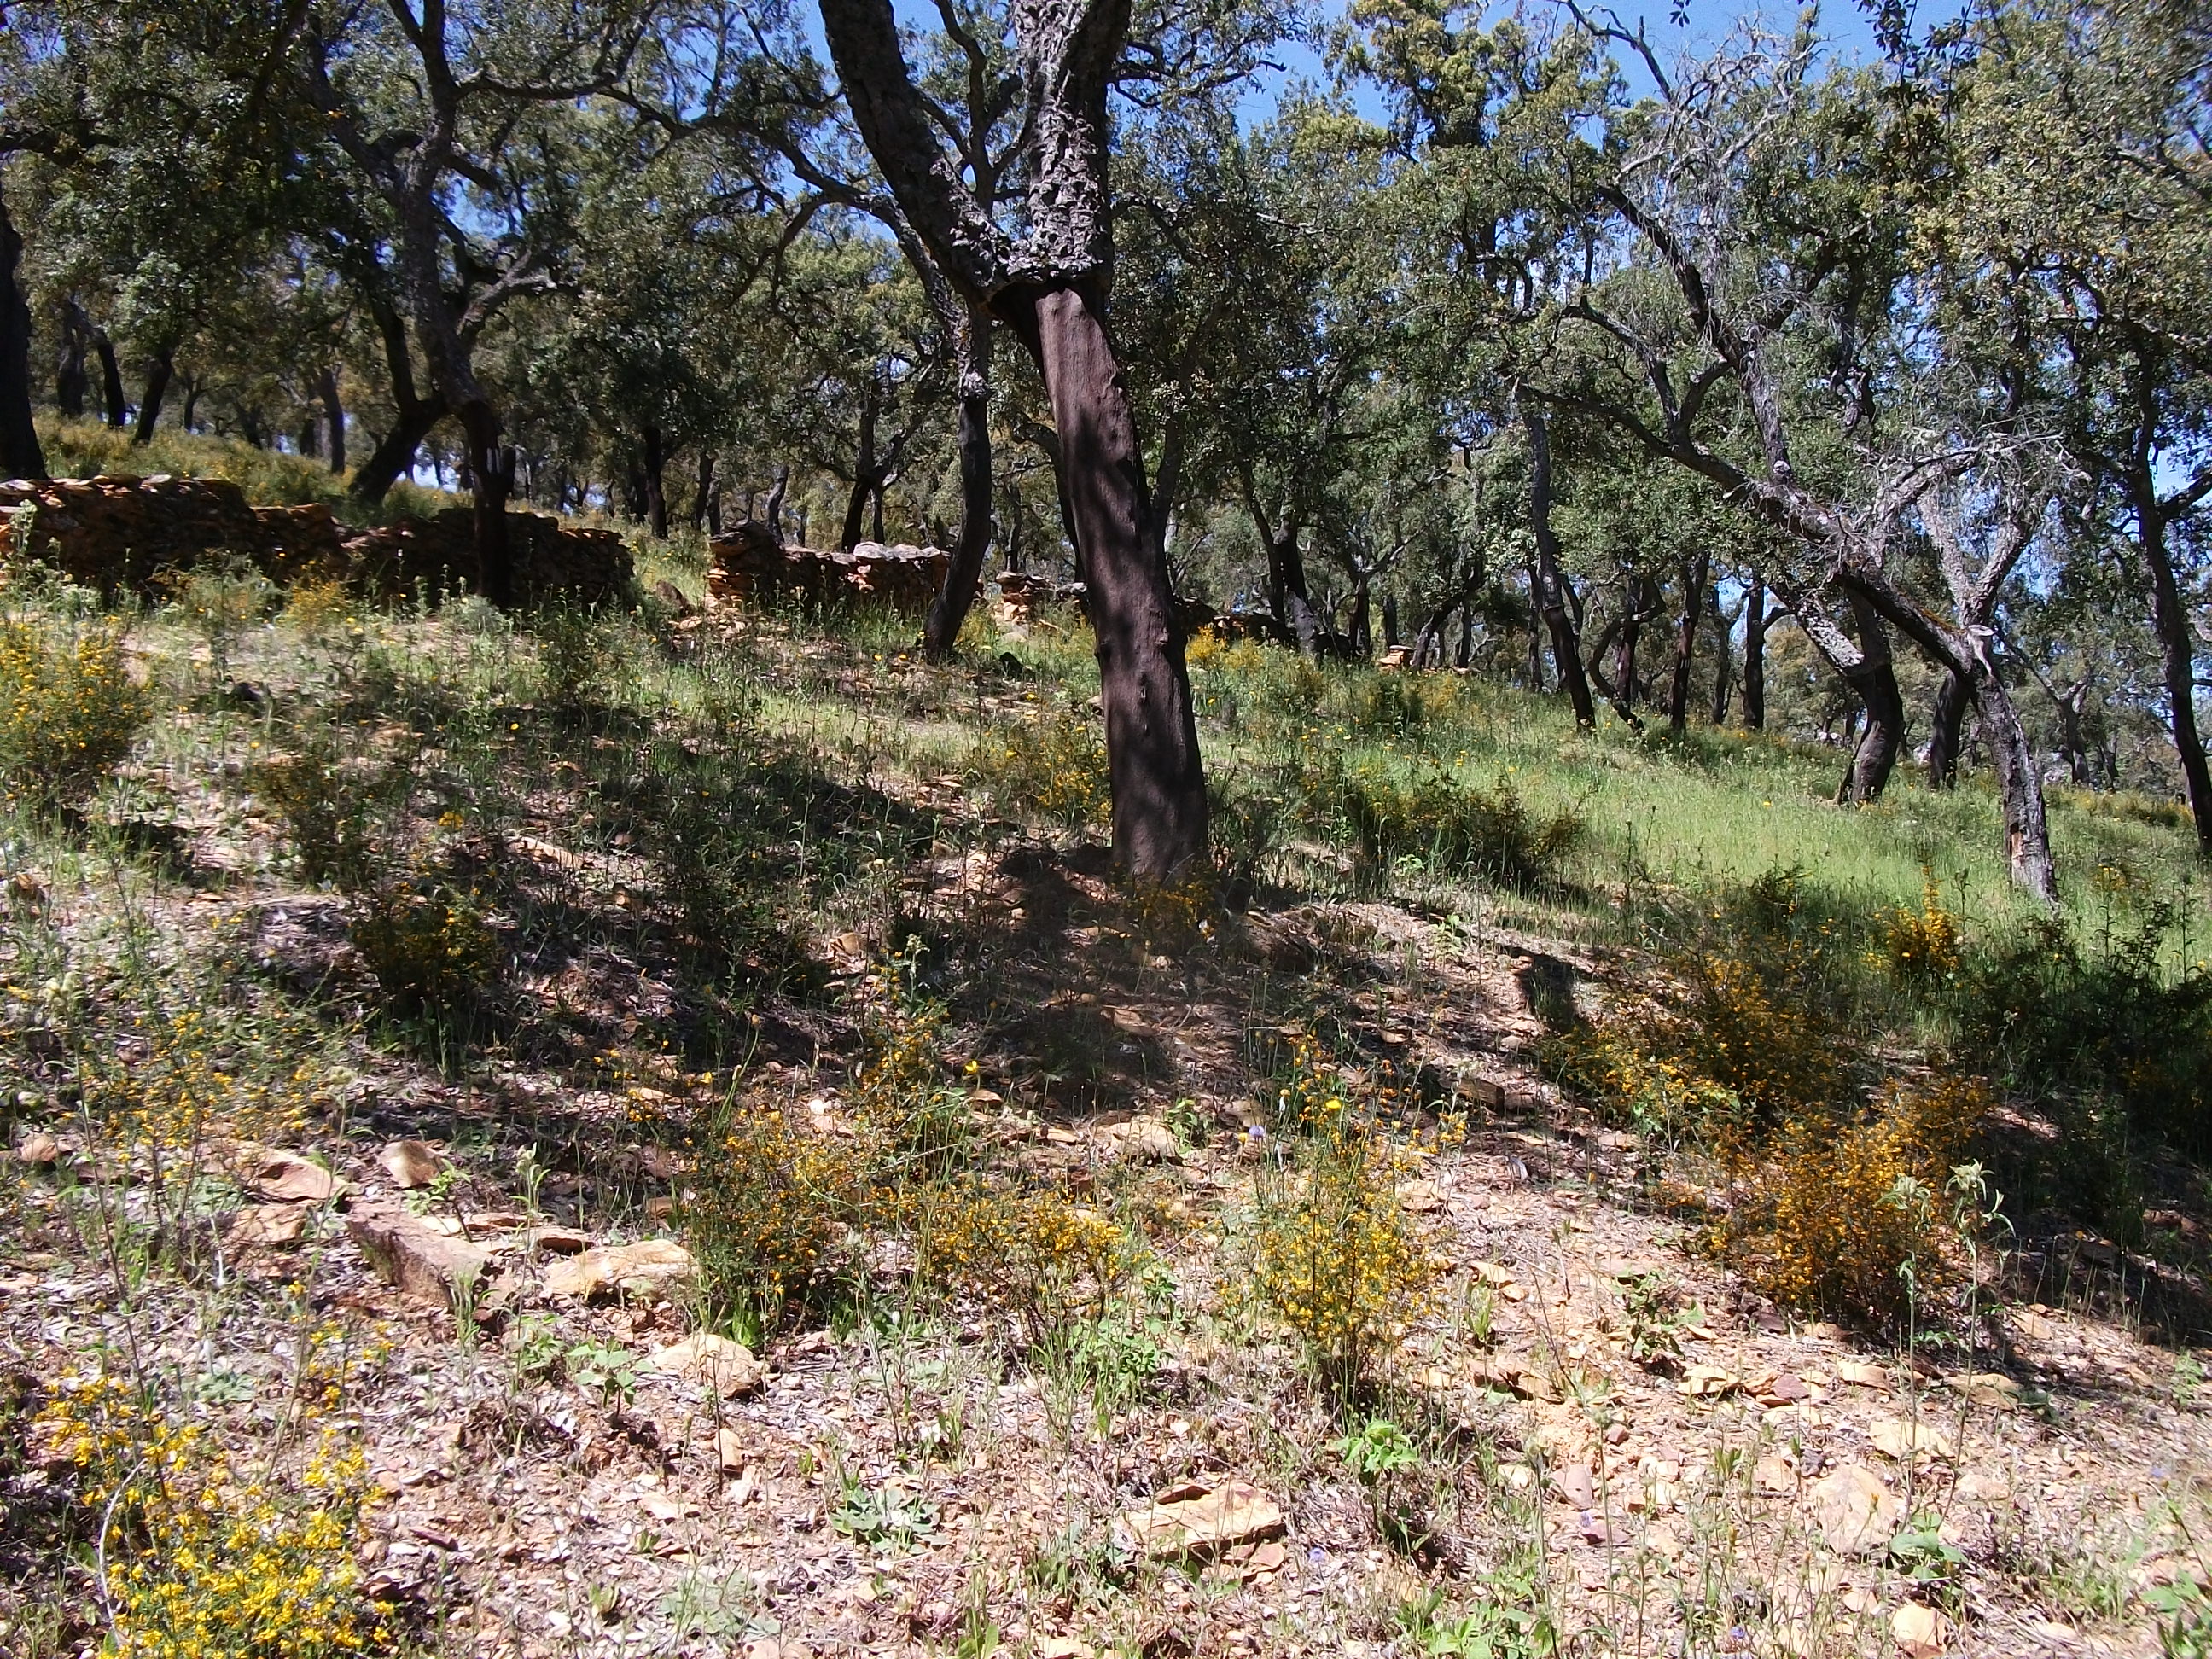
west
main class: Woodland
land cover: Broadleaved woodland
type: broadleaved evergreen forest
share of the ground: 50 - 75 %
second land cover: Spontaneously vegetated surfaces
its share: 10 - 25 %
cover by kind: broadleaved forest trees 70 %, herbaceous plants 20 %, shrubs 10 %
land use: Forestry
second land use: Agriculture (excluding fallow land and kitchen gardens)
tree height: > 5 m
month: April
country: ES
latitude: 37.7617
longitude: -6.5569
